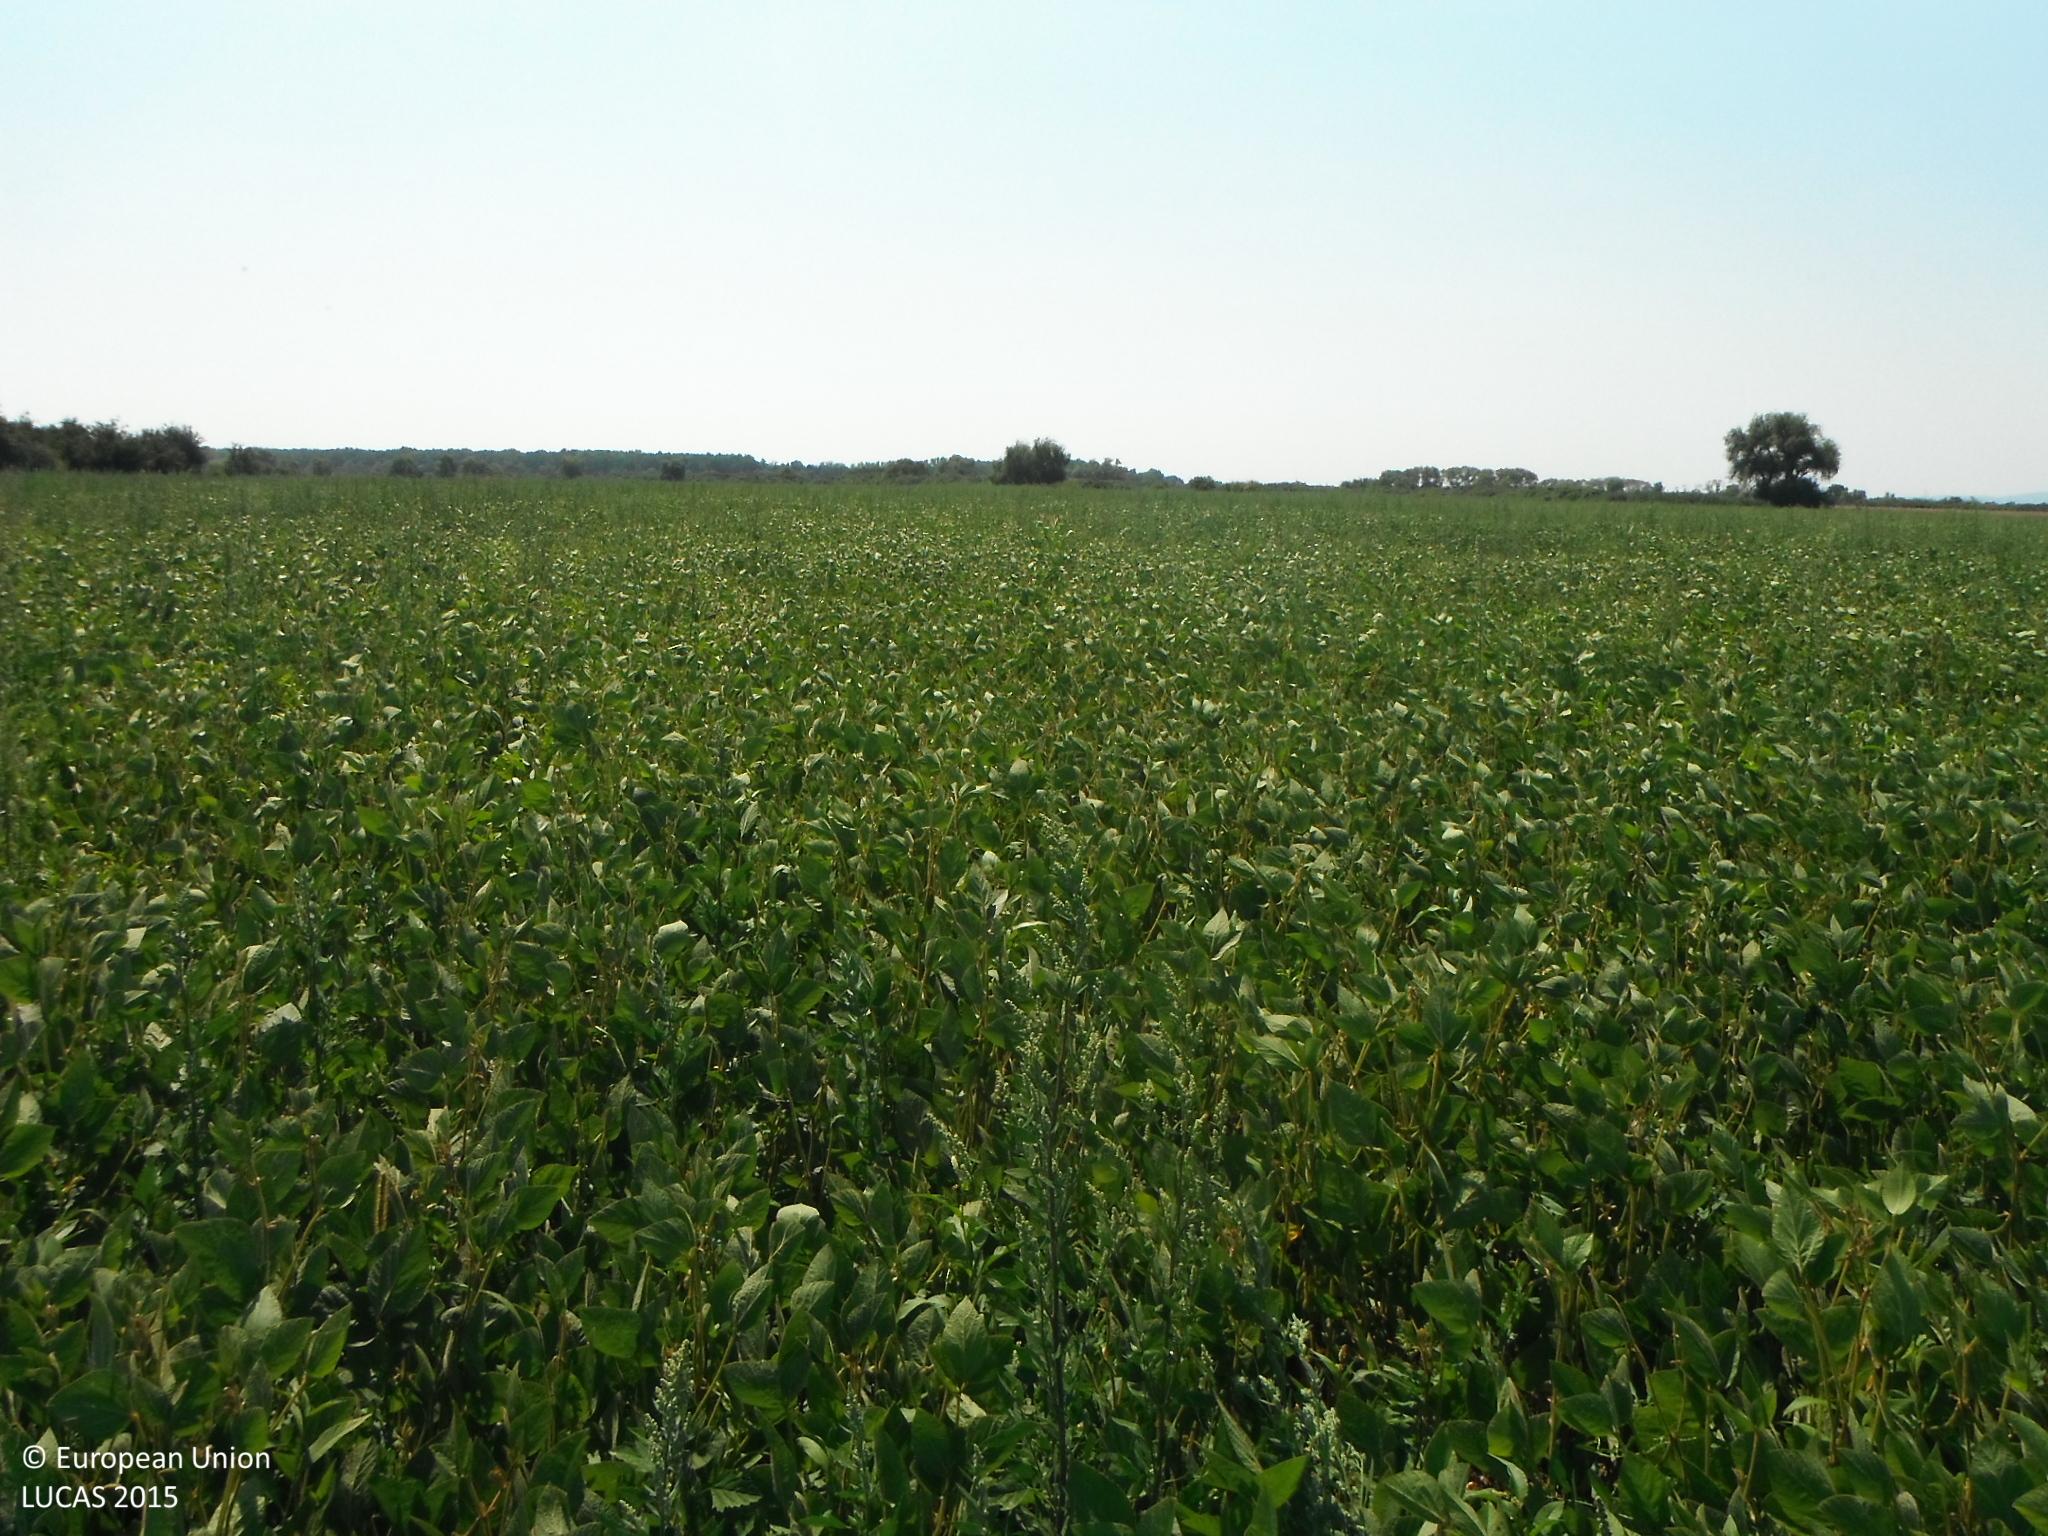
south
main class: Cropland
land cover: Soya
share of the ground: > 75 %
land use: Agriculture (excluding fallow land and kitchen gardens)
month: August
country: SK
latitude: 48.6844
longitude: 21.9114
